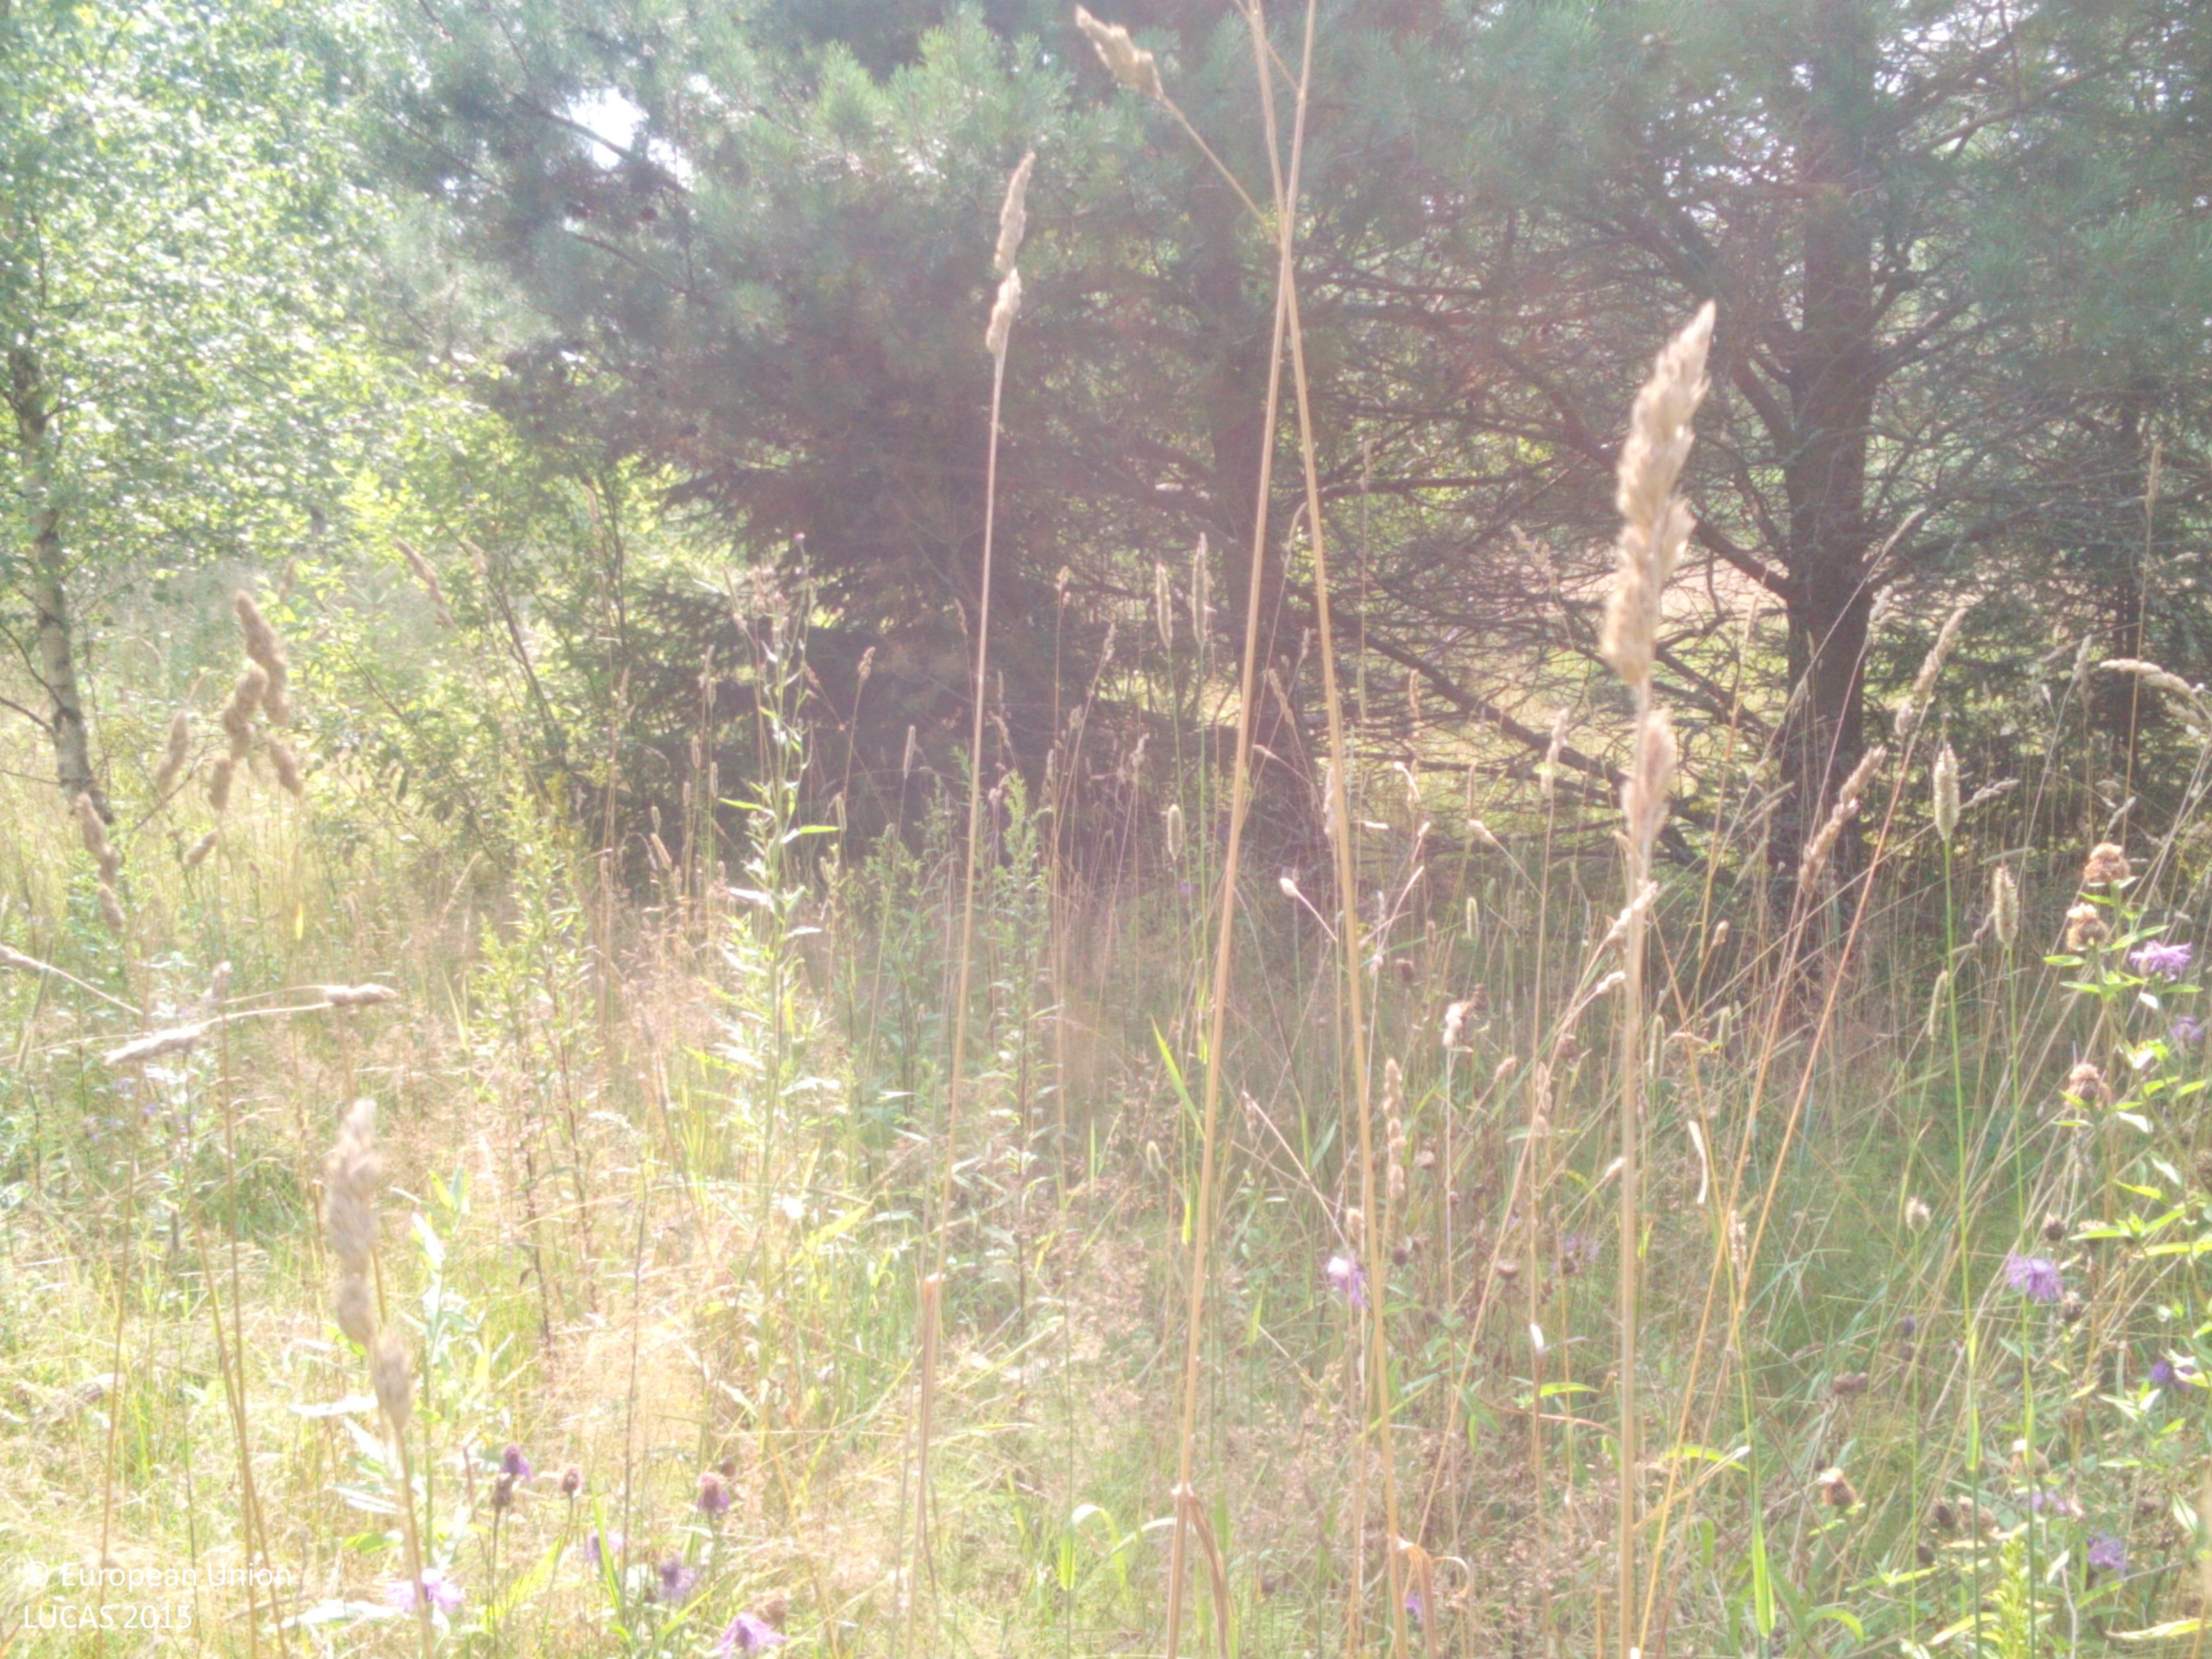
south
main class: Woodland
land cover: Pine dominated mixed woodland
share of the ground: 50 - 75 %
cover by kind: herbaceous plants 50 %, coniferous forest trees 25 %, broadleaved forest trees 25 %
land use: Forestry
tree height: > 5 m
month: August
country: LV
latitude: 56.9364
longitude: 21.7620
